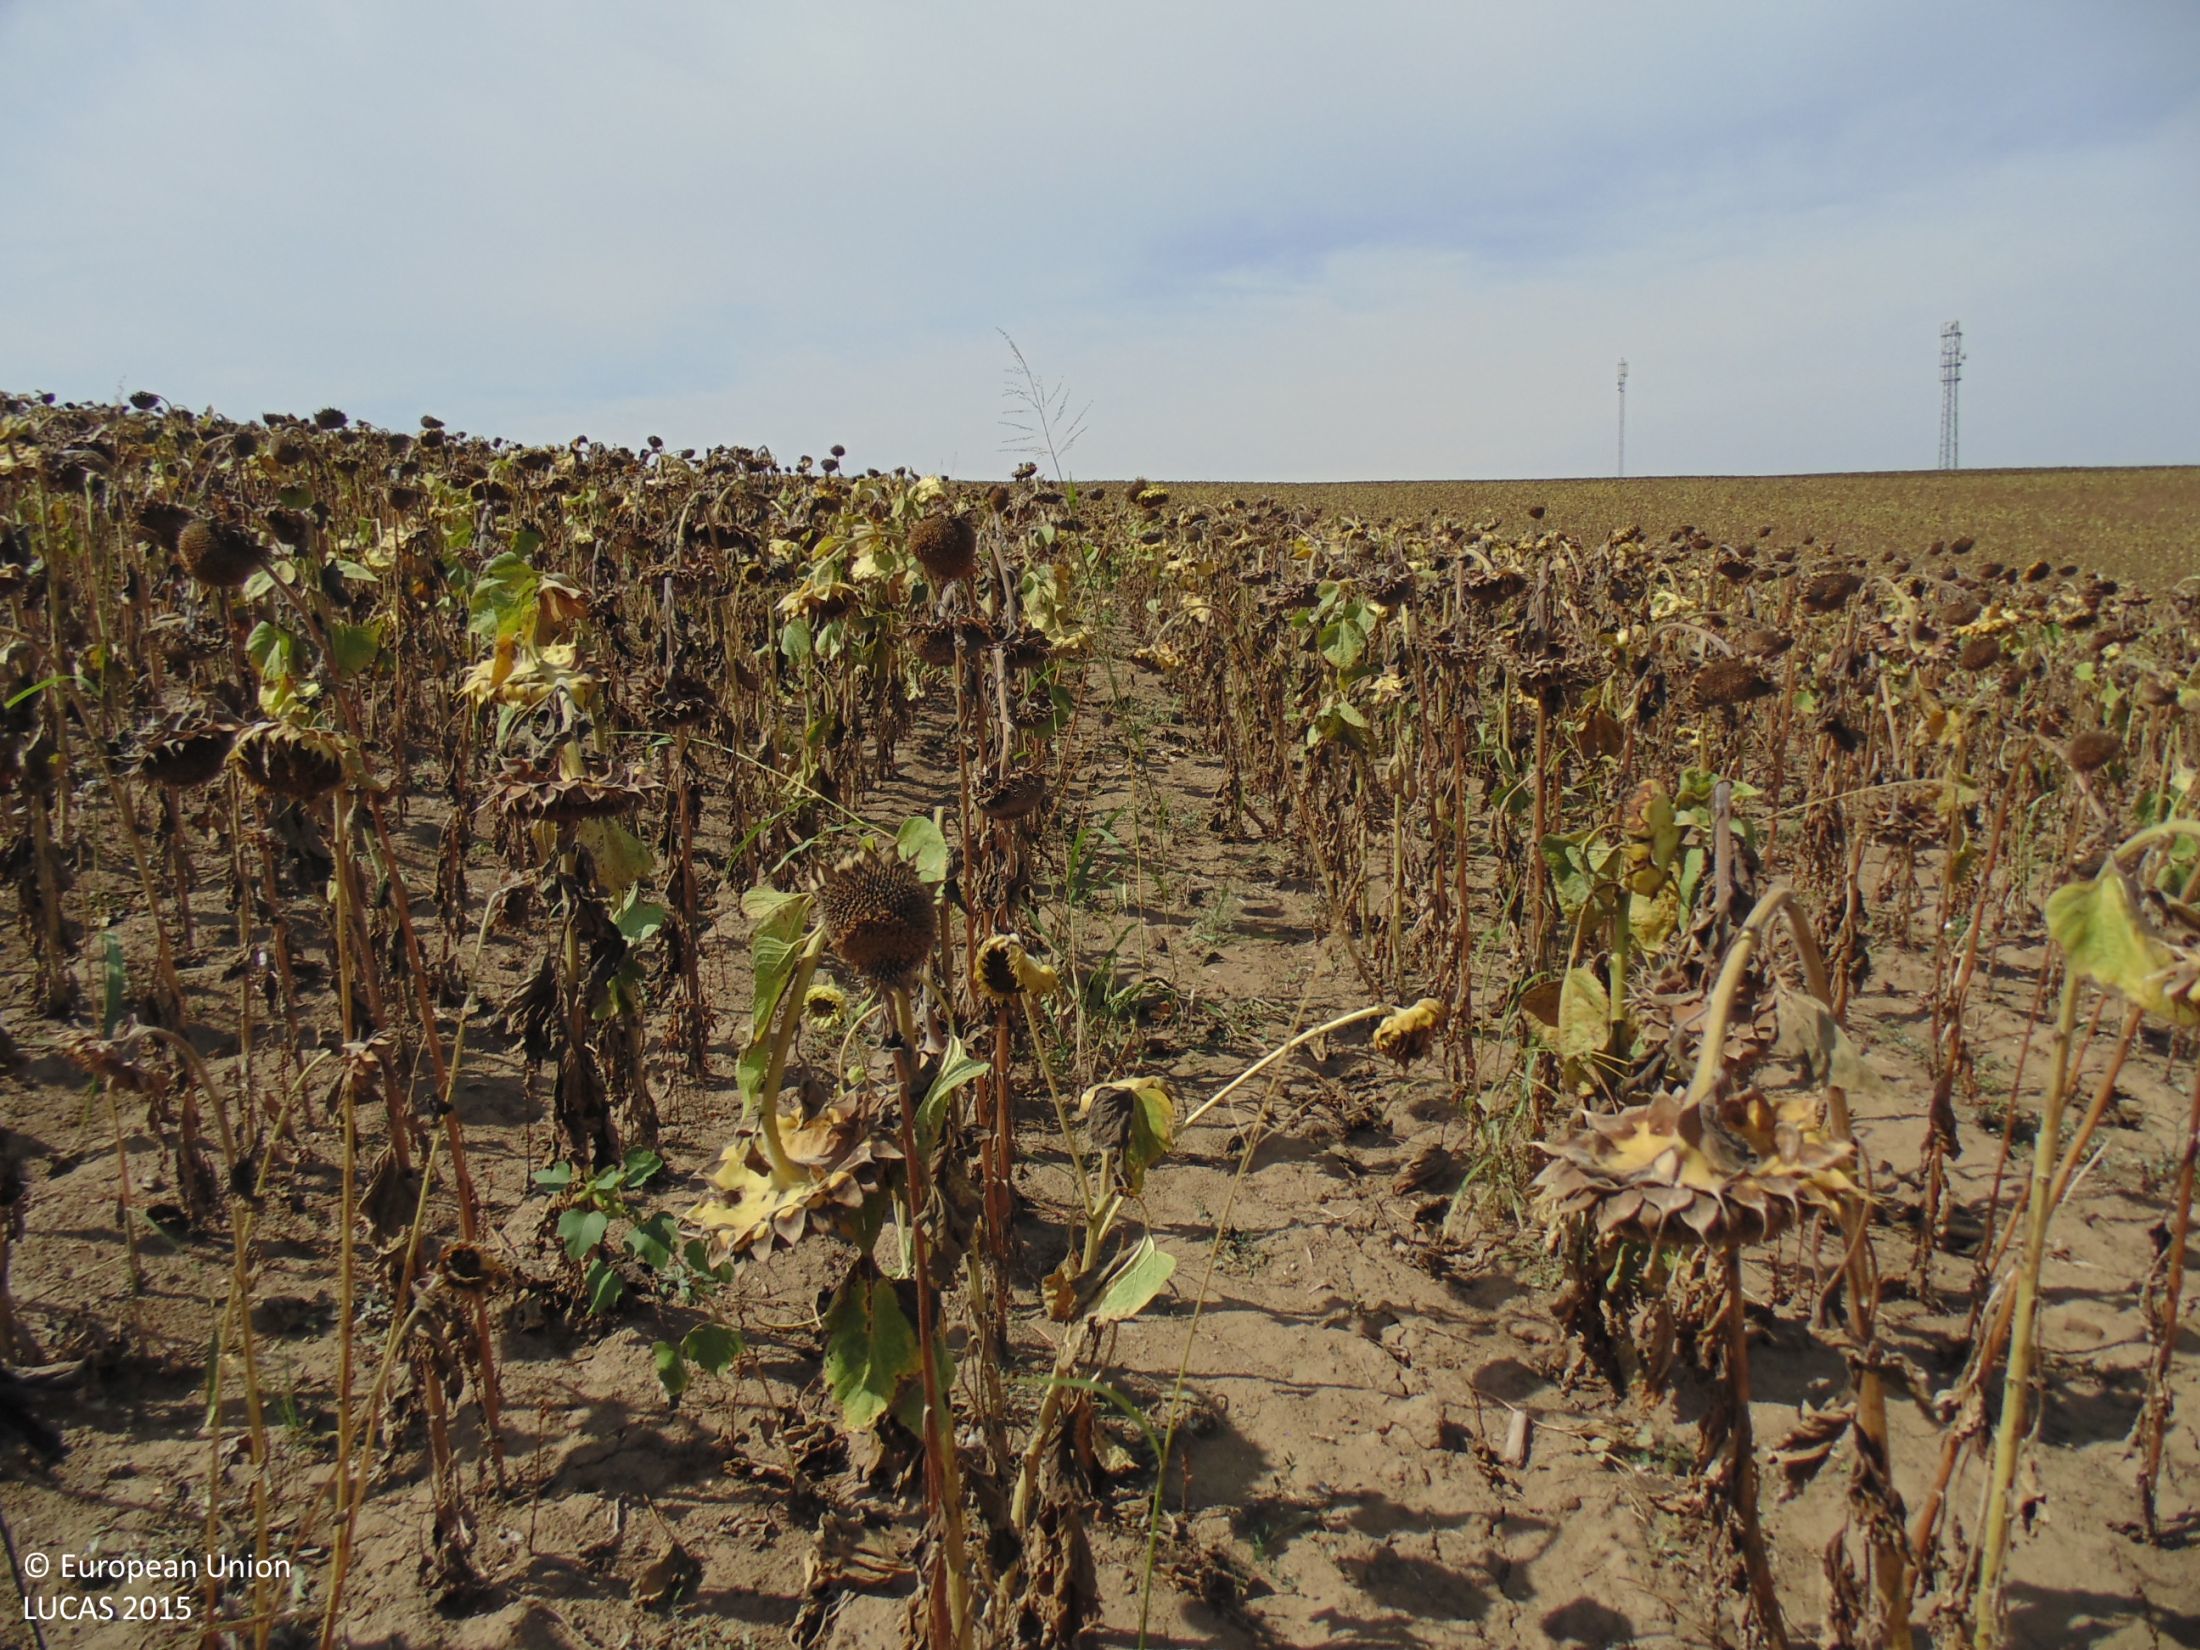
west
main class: Cropland
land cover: Sunflower
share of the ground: > 75 %
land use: Agriculture (excluding fallow land and kitchen gardens)
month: September
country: BG
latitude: 44.0093
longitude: 27.1786
